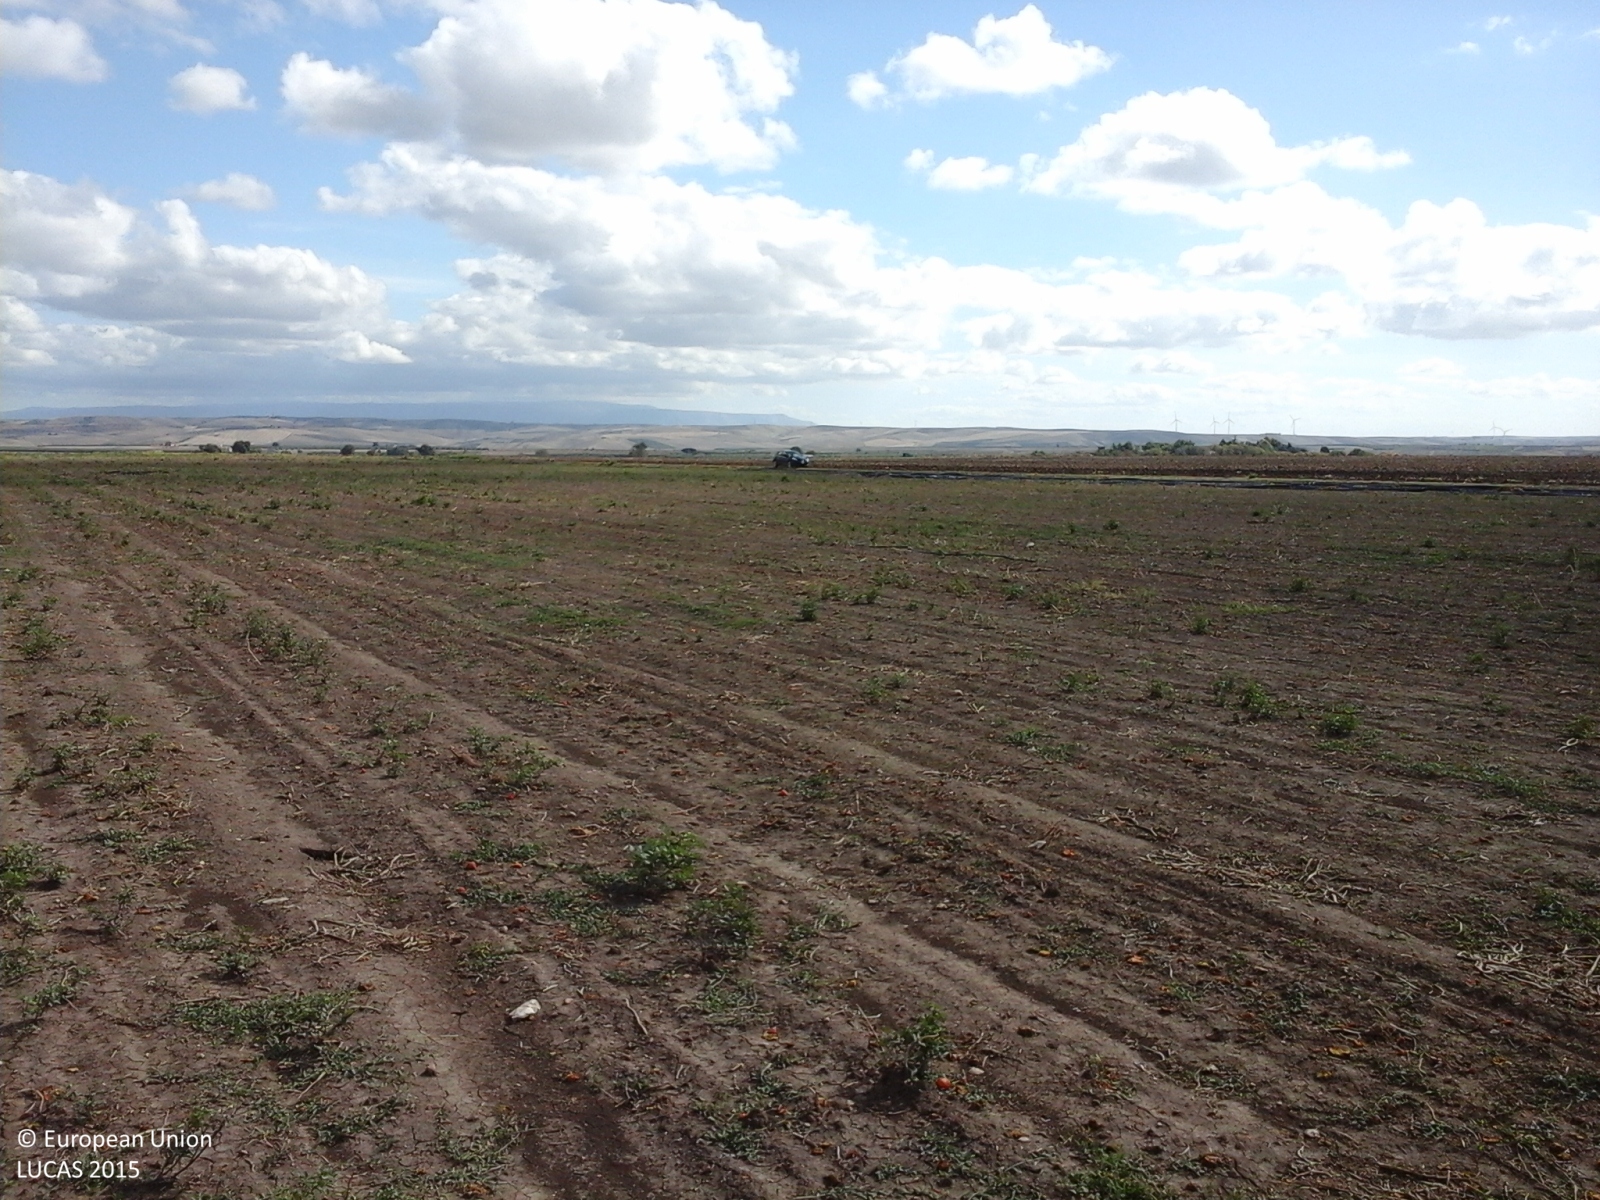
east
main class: Cropland
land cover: Tomatoes
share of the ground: < 10 %
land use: Agriculture (excluding fallow land and kitchen gardens)
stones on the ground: < 10 %
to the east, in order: Tomatoes; Grass margins; Tracks; Dry pulses
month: September
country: IT
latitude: 41.6730
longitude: 15.1363
